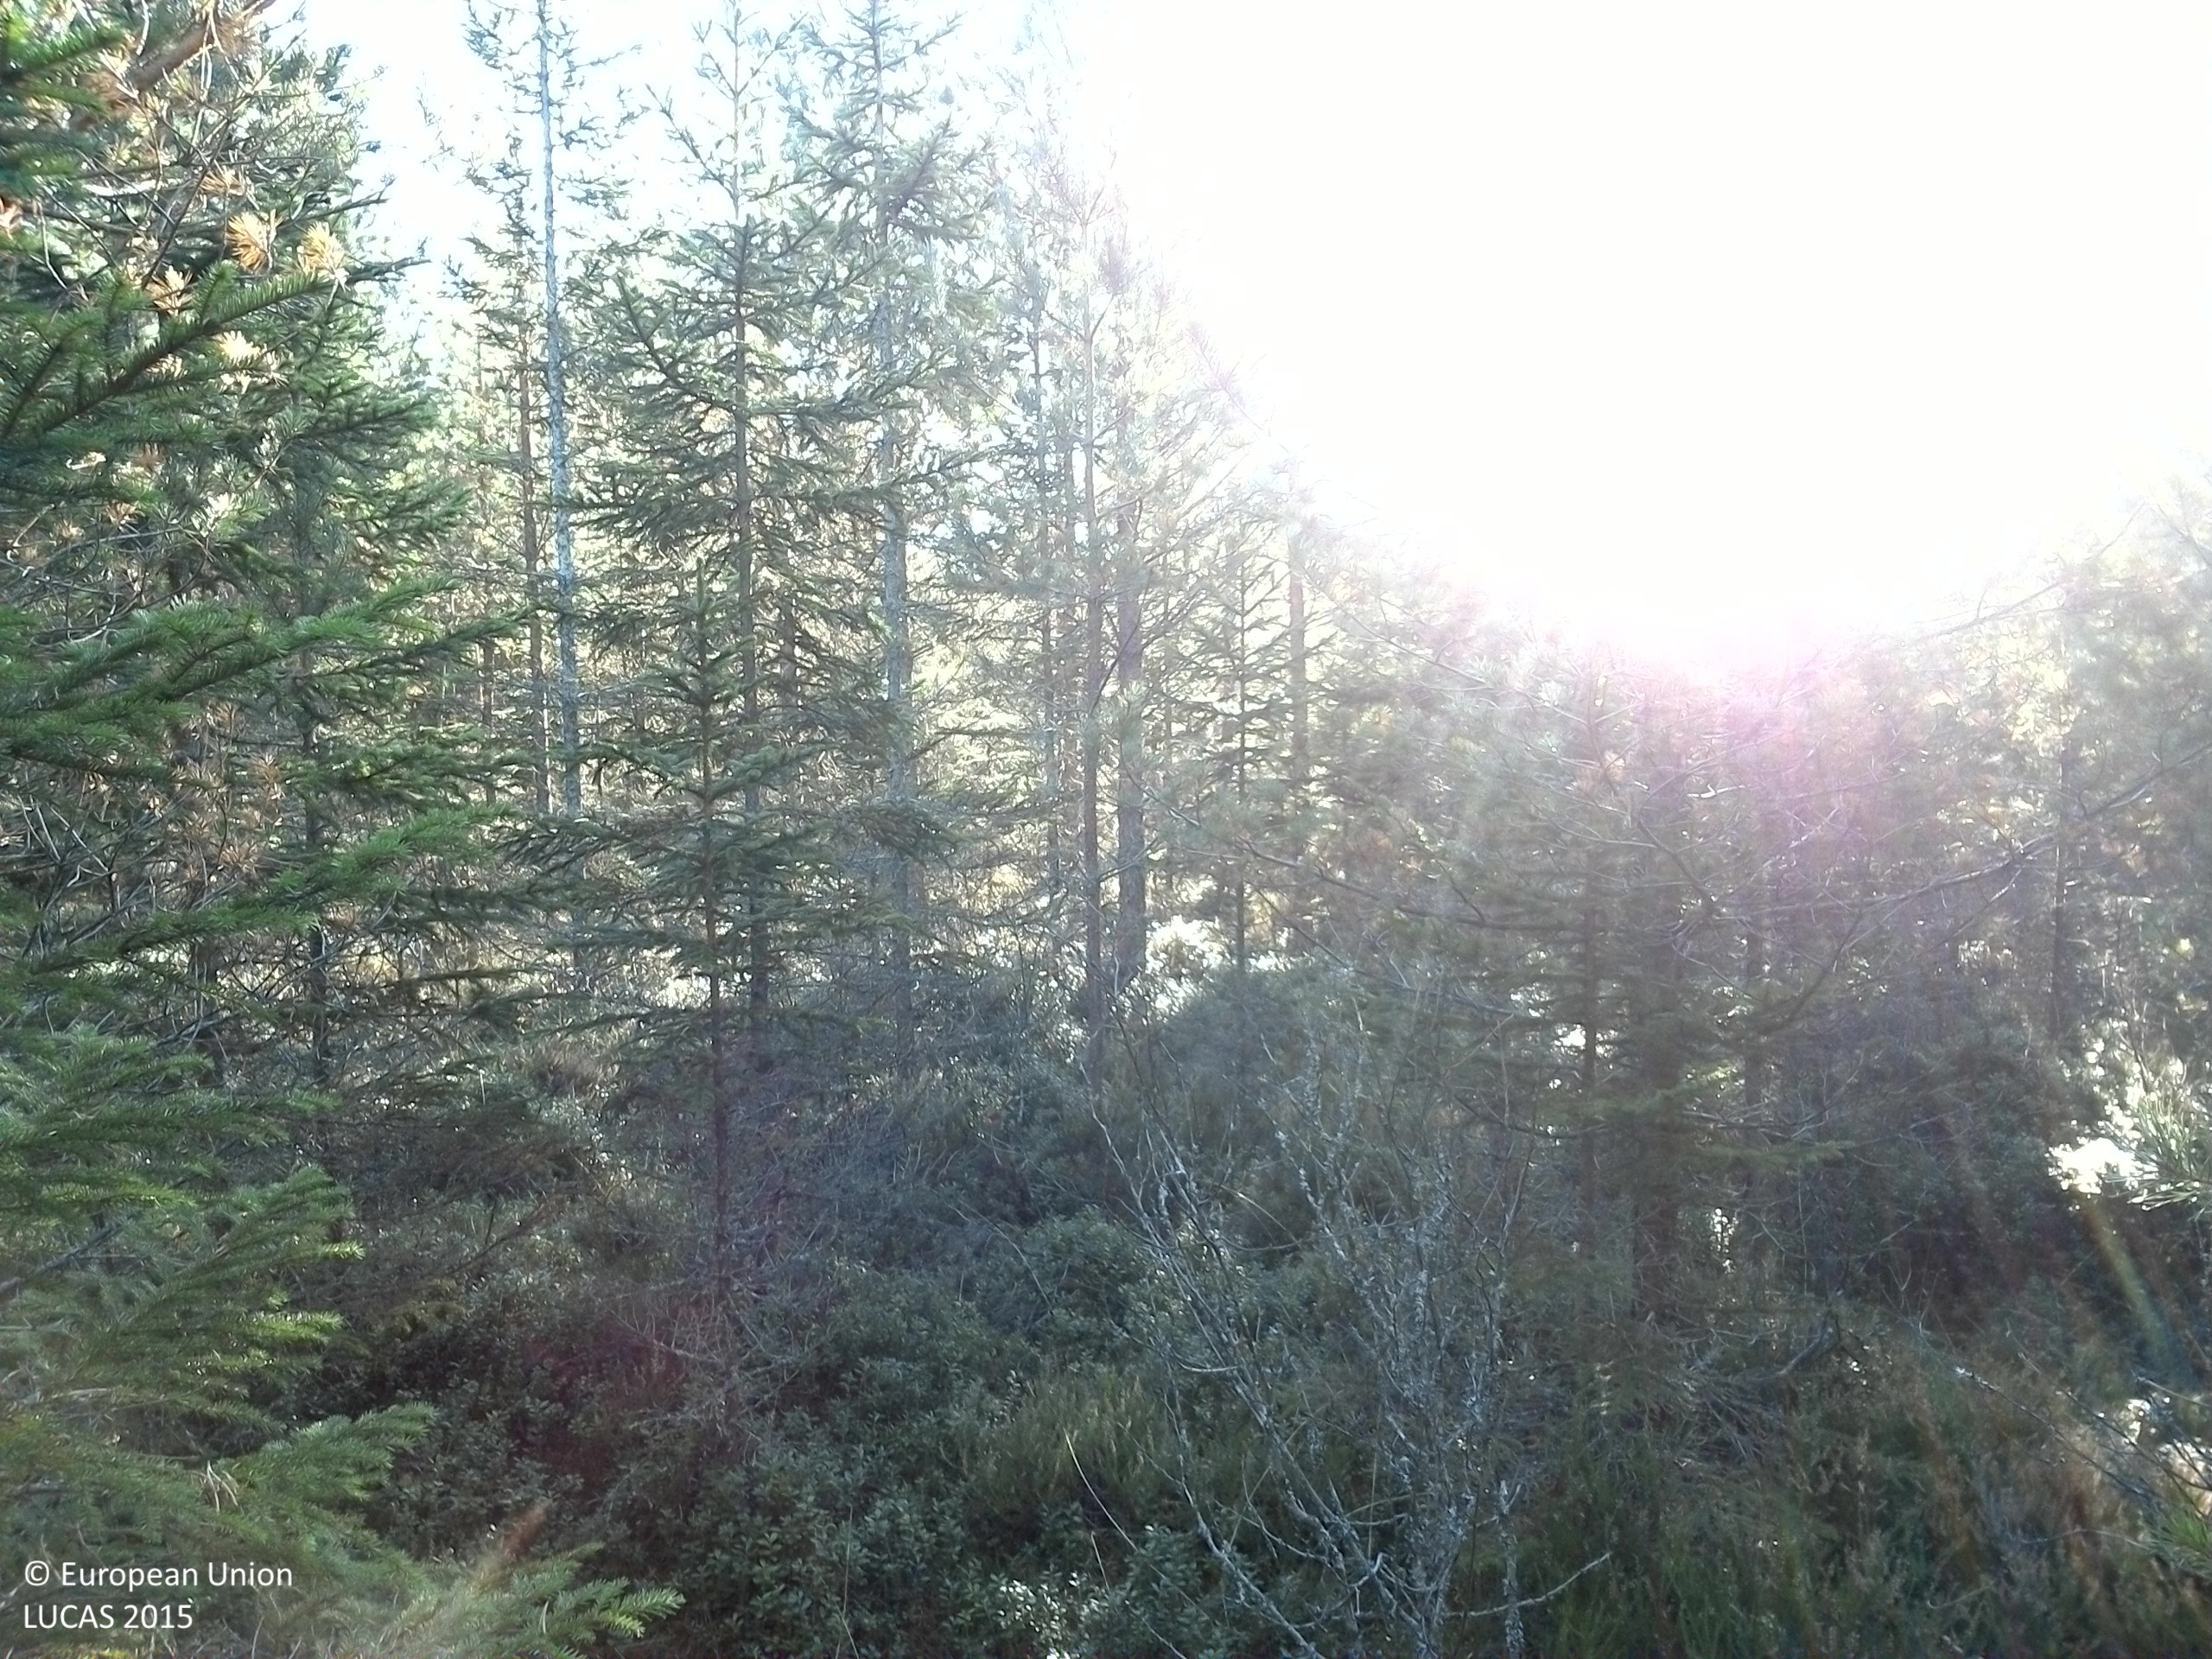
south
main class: Woodland
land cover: Other coniferous woodland
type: boreal forest
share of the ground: > 75 %
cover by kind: coniferous forest trees 75 %, shrubs 15 %, broadleaved forest trees 5 %, lichens and mosses 5 %
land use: Forestry
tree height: > 5 m
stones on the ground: < 10 %
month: October
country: SE
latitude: 59.4575
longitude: 15.0896
